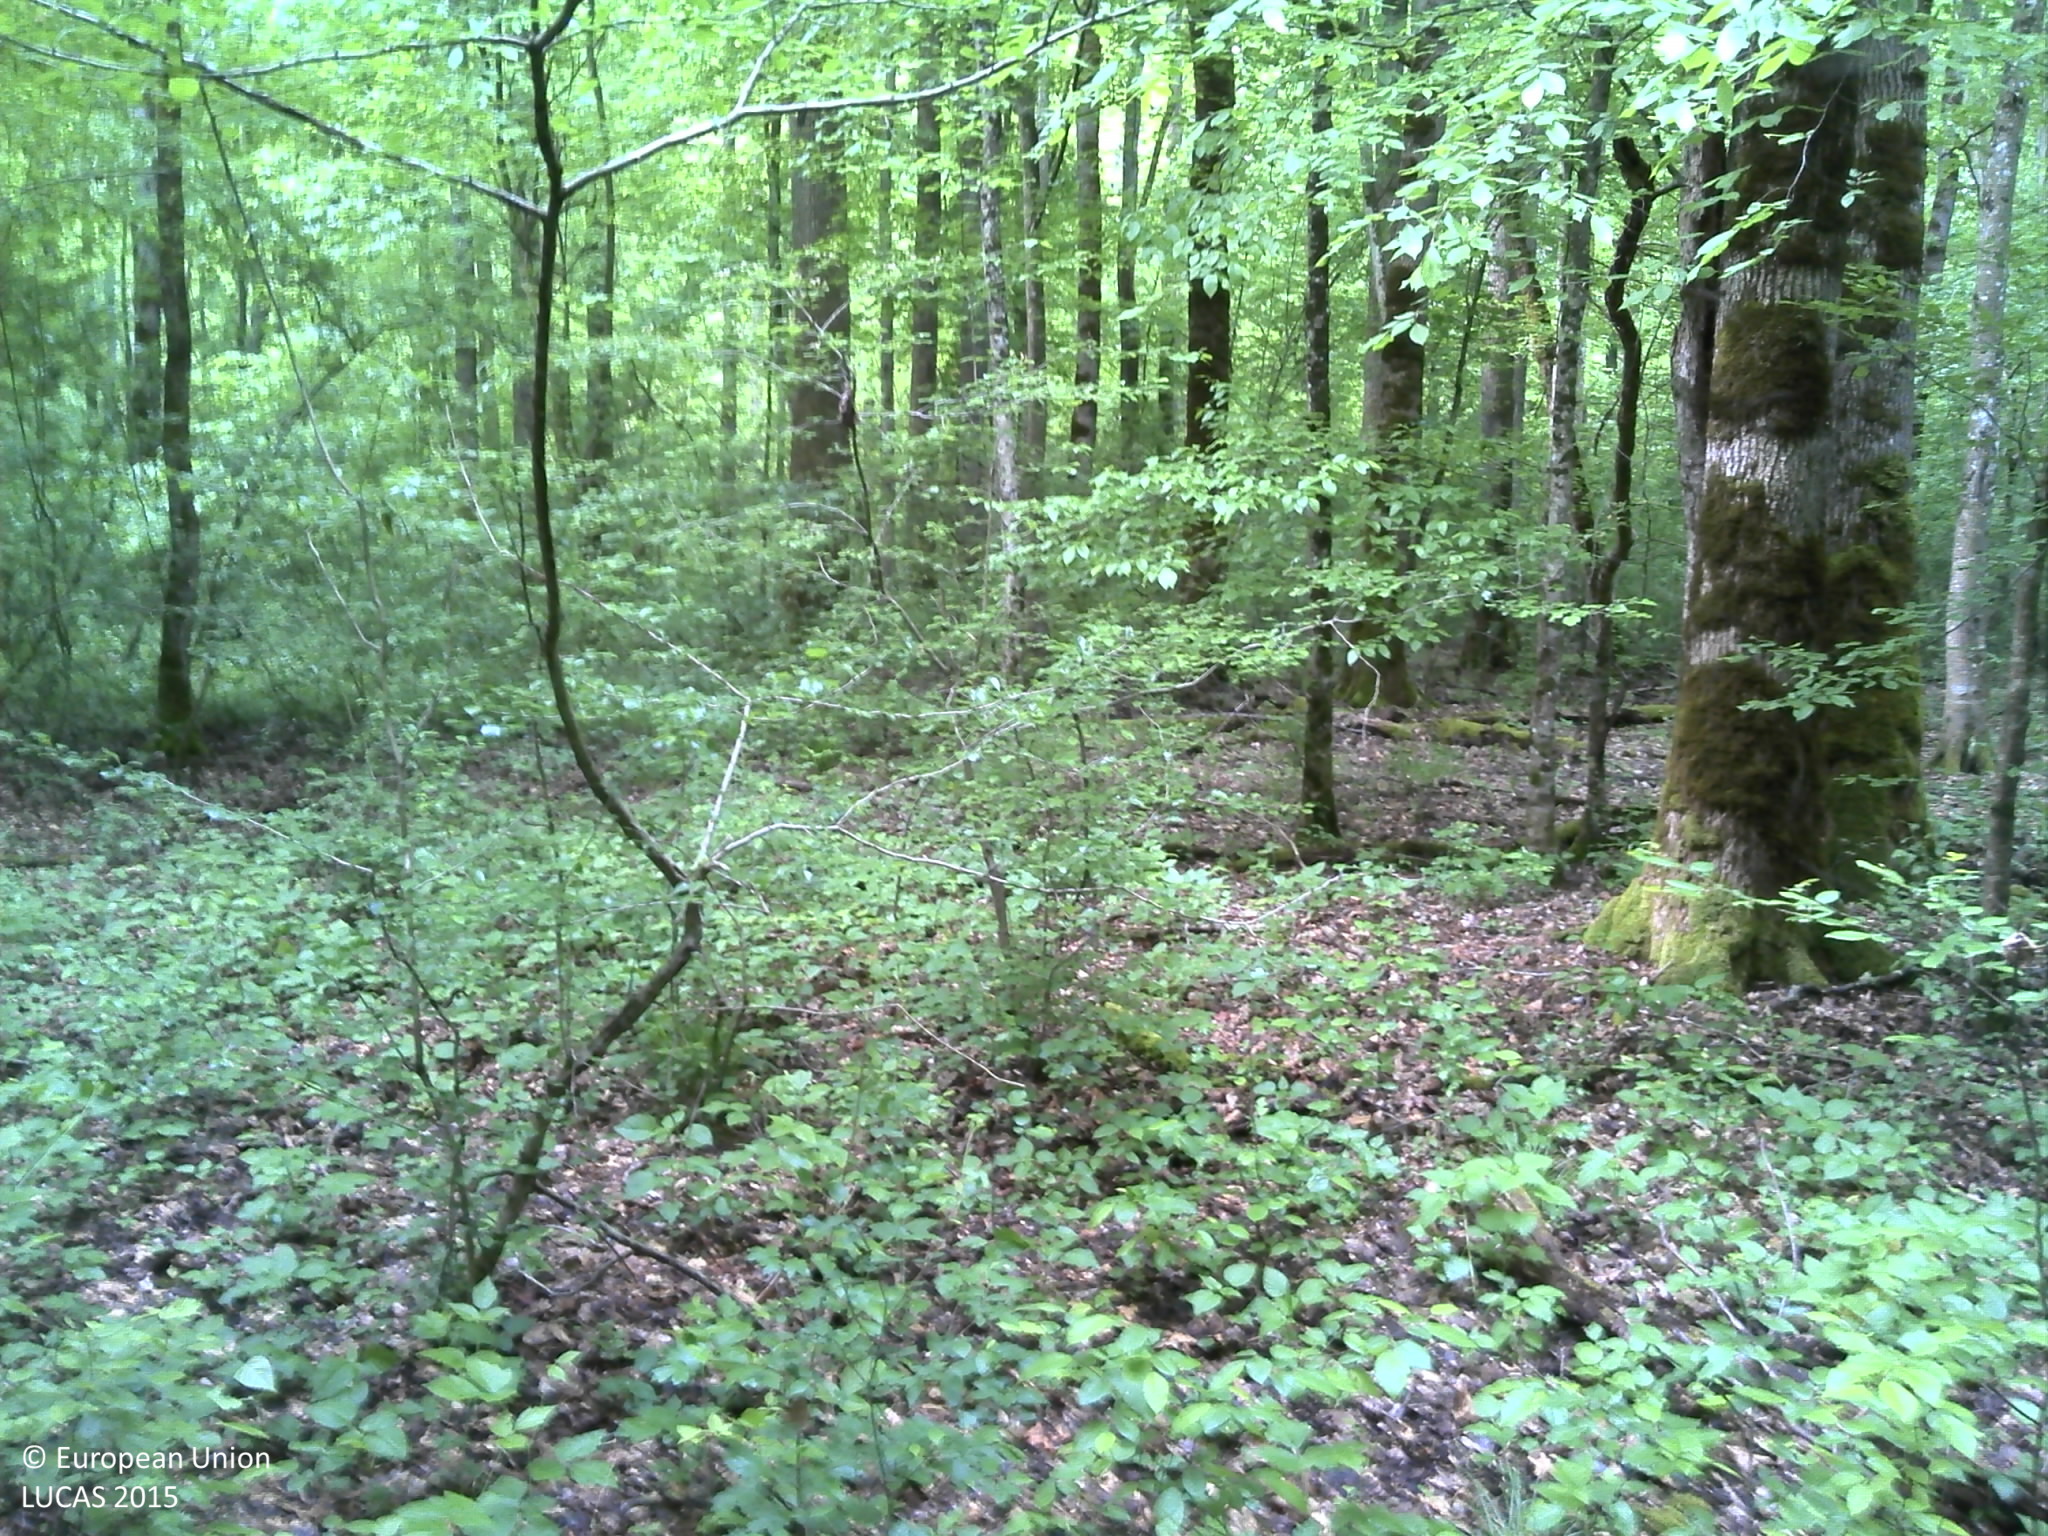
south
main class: Woodland
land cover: Broadleaved woodland
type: mesophytic deciduous forest
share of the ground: > 75 %
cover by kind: broadleaved forest trees 100 %
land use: Forestry
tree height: > 5 m
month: May
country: HR
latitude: 45.0347
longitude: 18.9304
